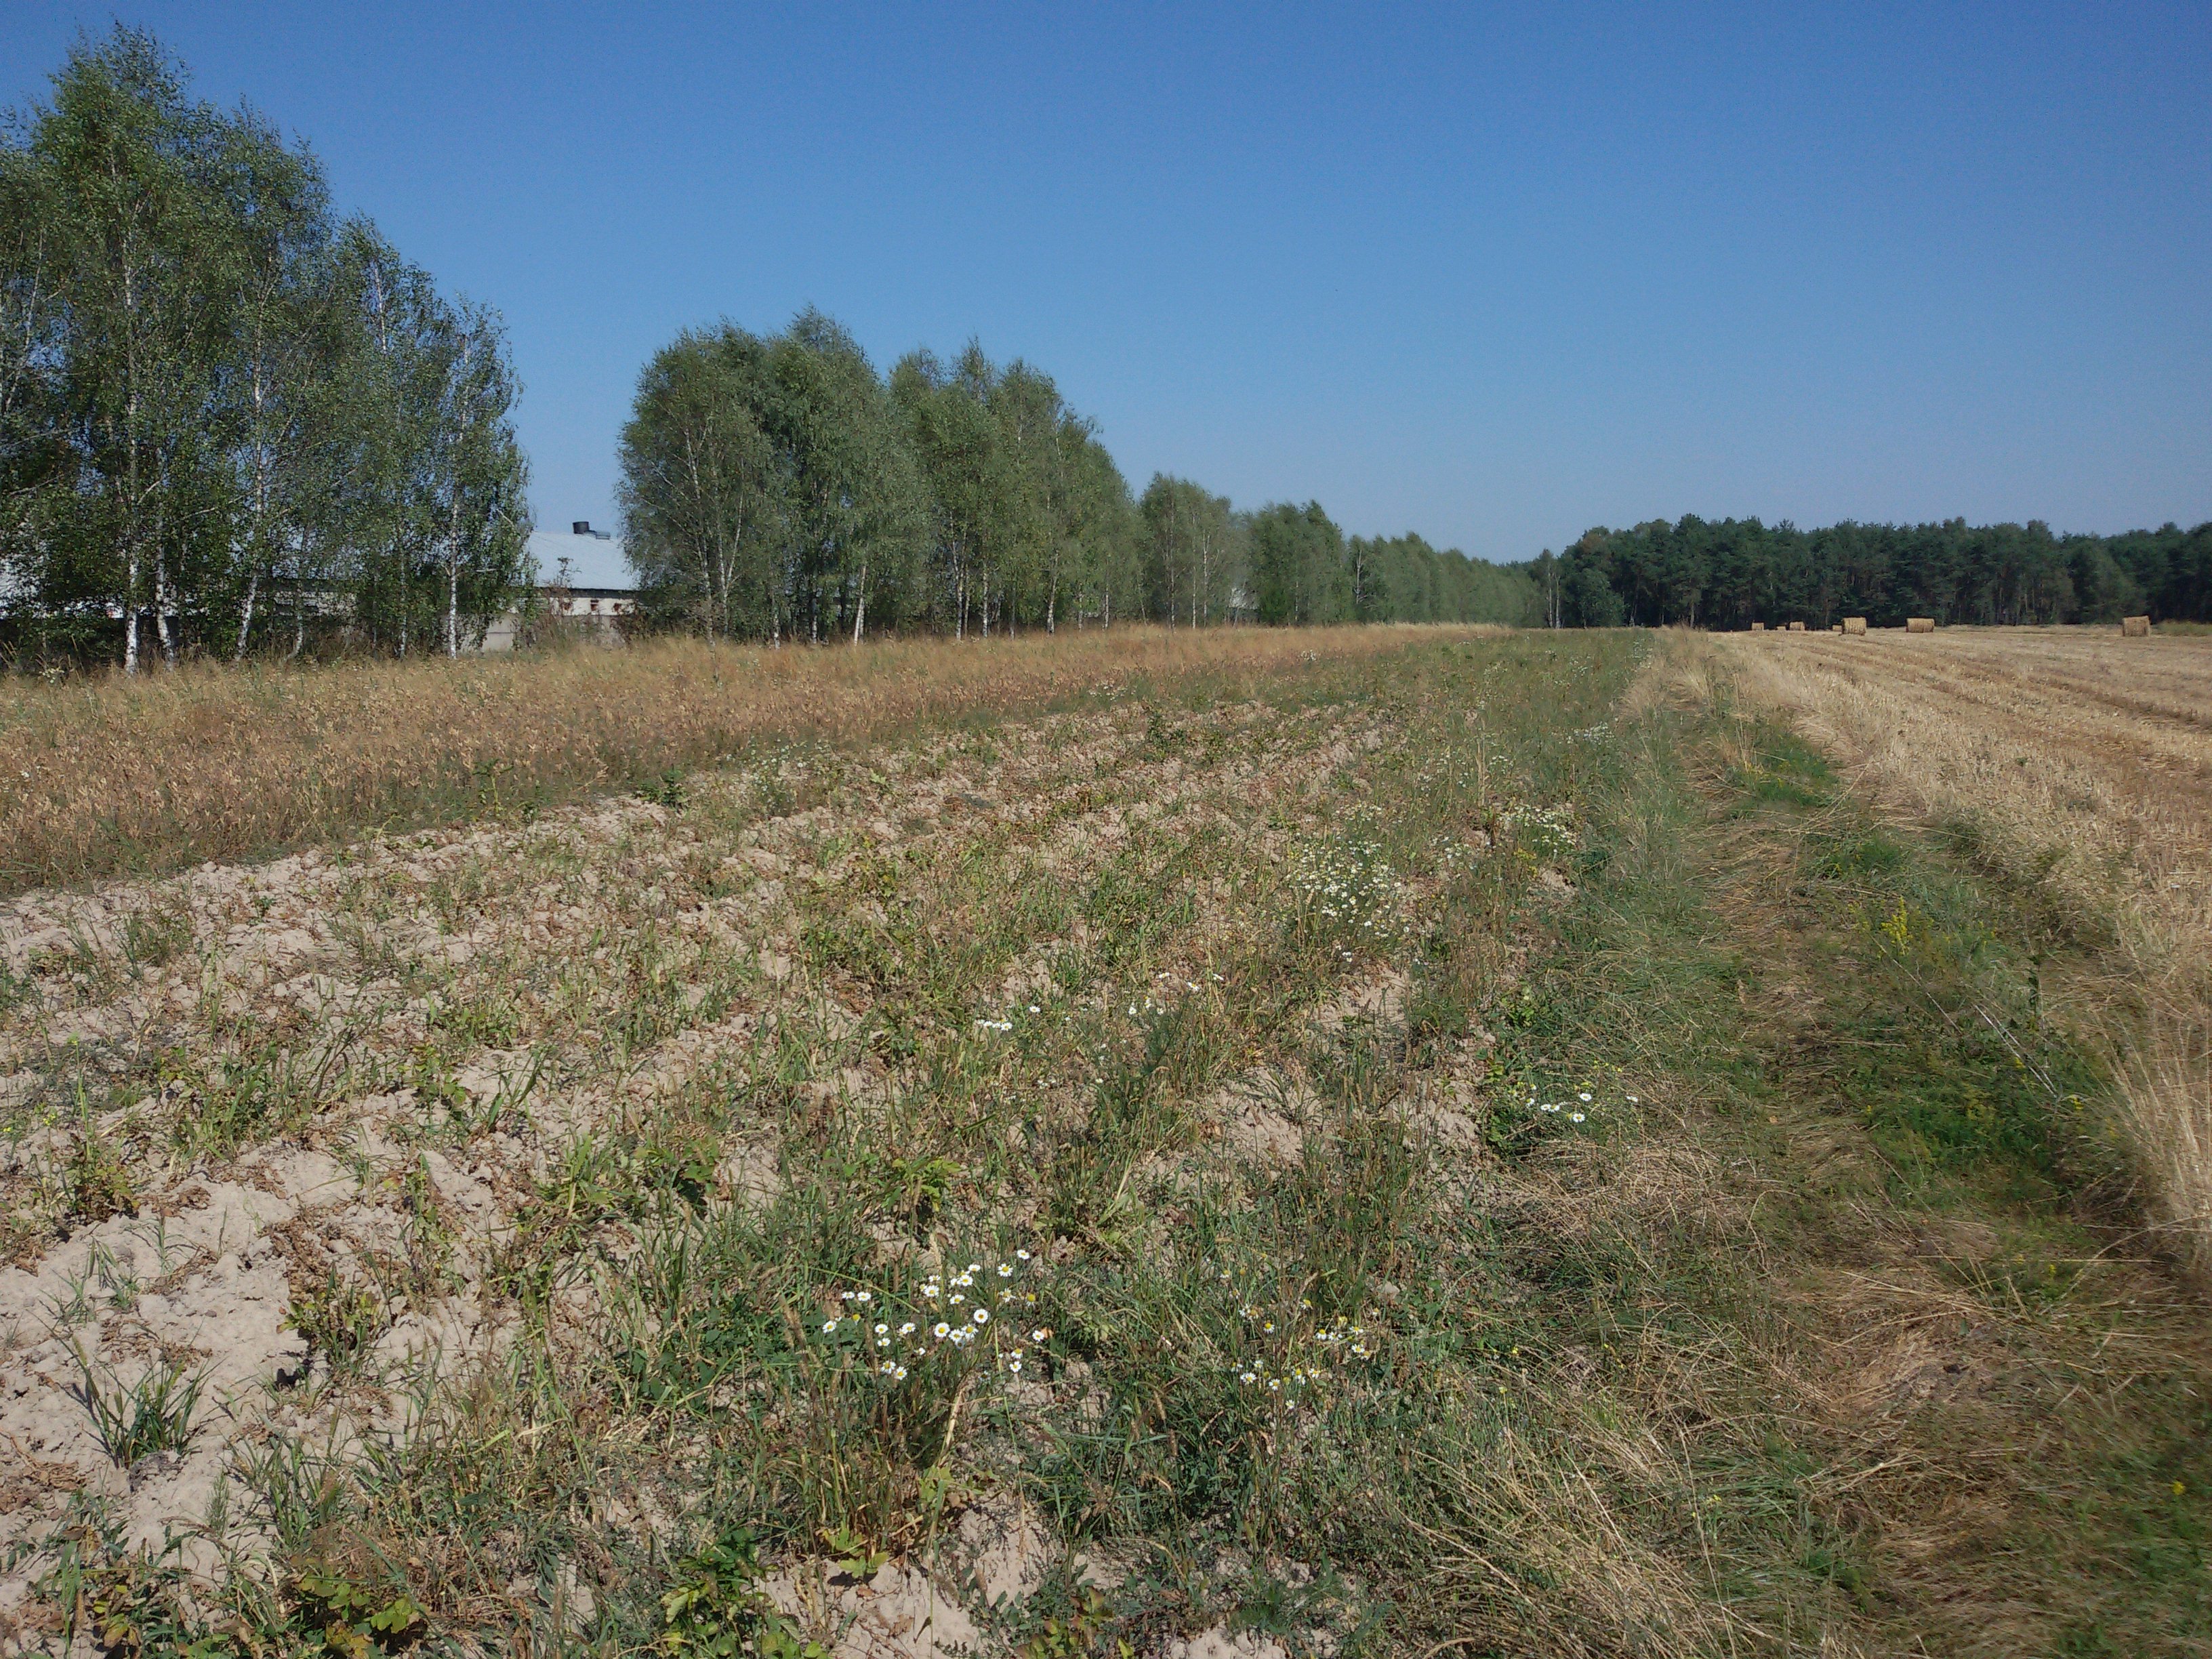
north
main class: Cropland
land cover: Potatoes
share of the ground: 25 - 50 %
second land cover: Spontaneously vegetated surfaces
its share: 50 - 75 %
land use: Agriculture (excluding fallow land and kitchen gardens)
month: August
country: PL
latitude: 52.1982
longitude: 22.0416
